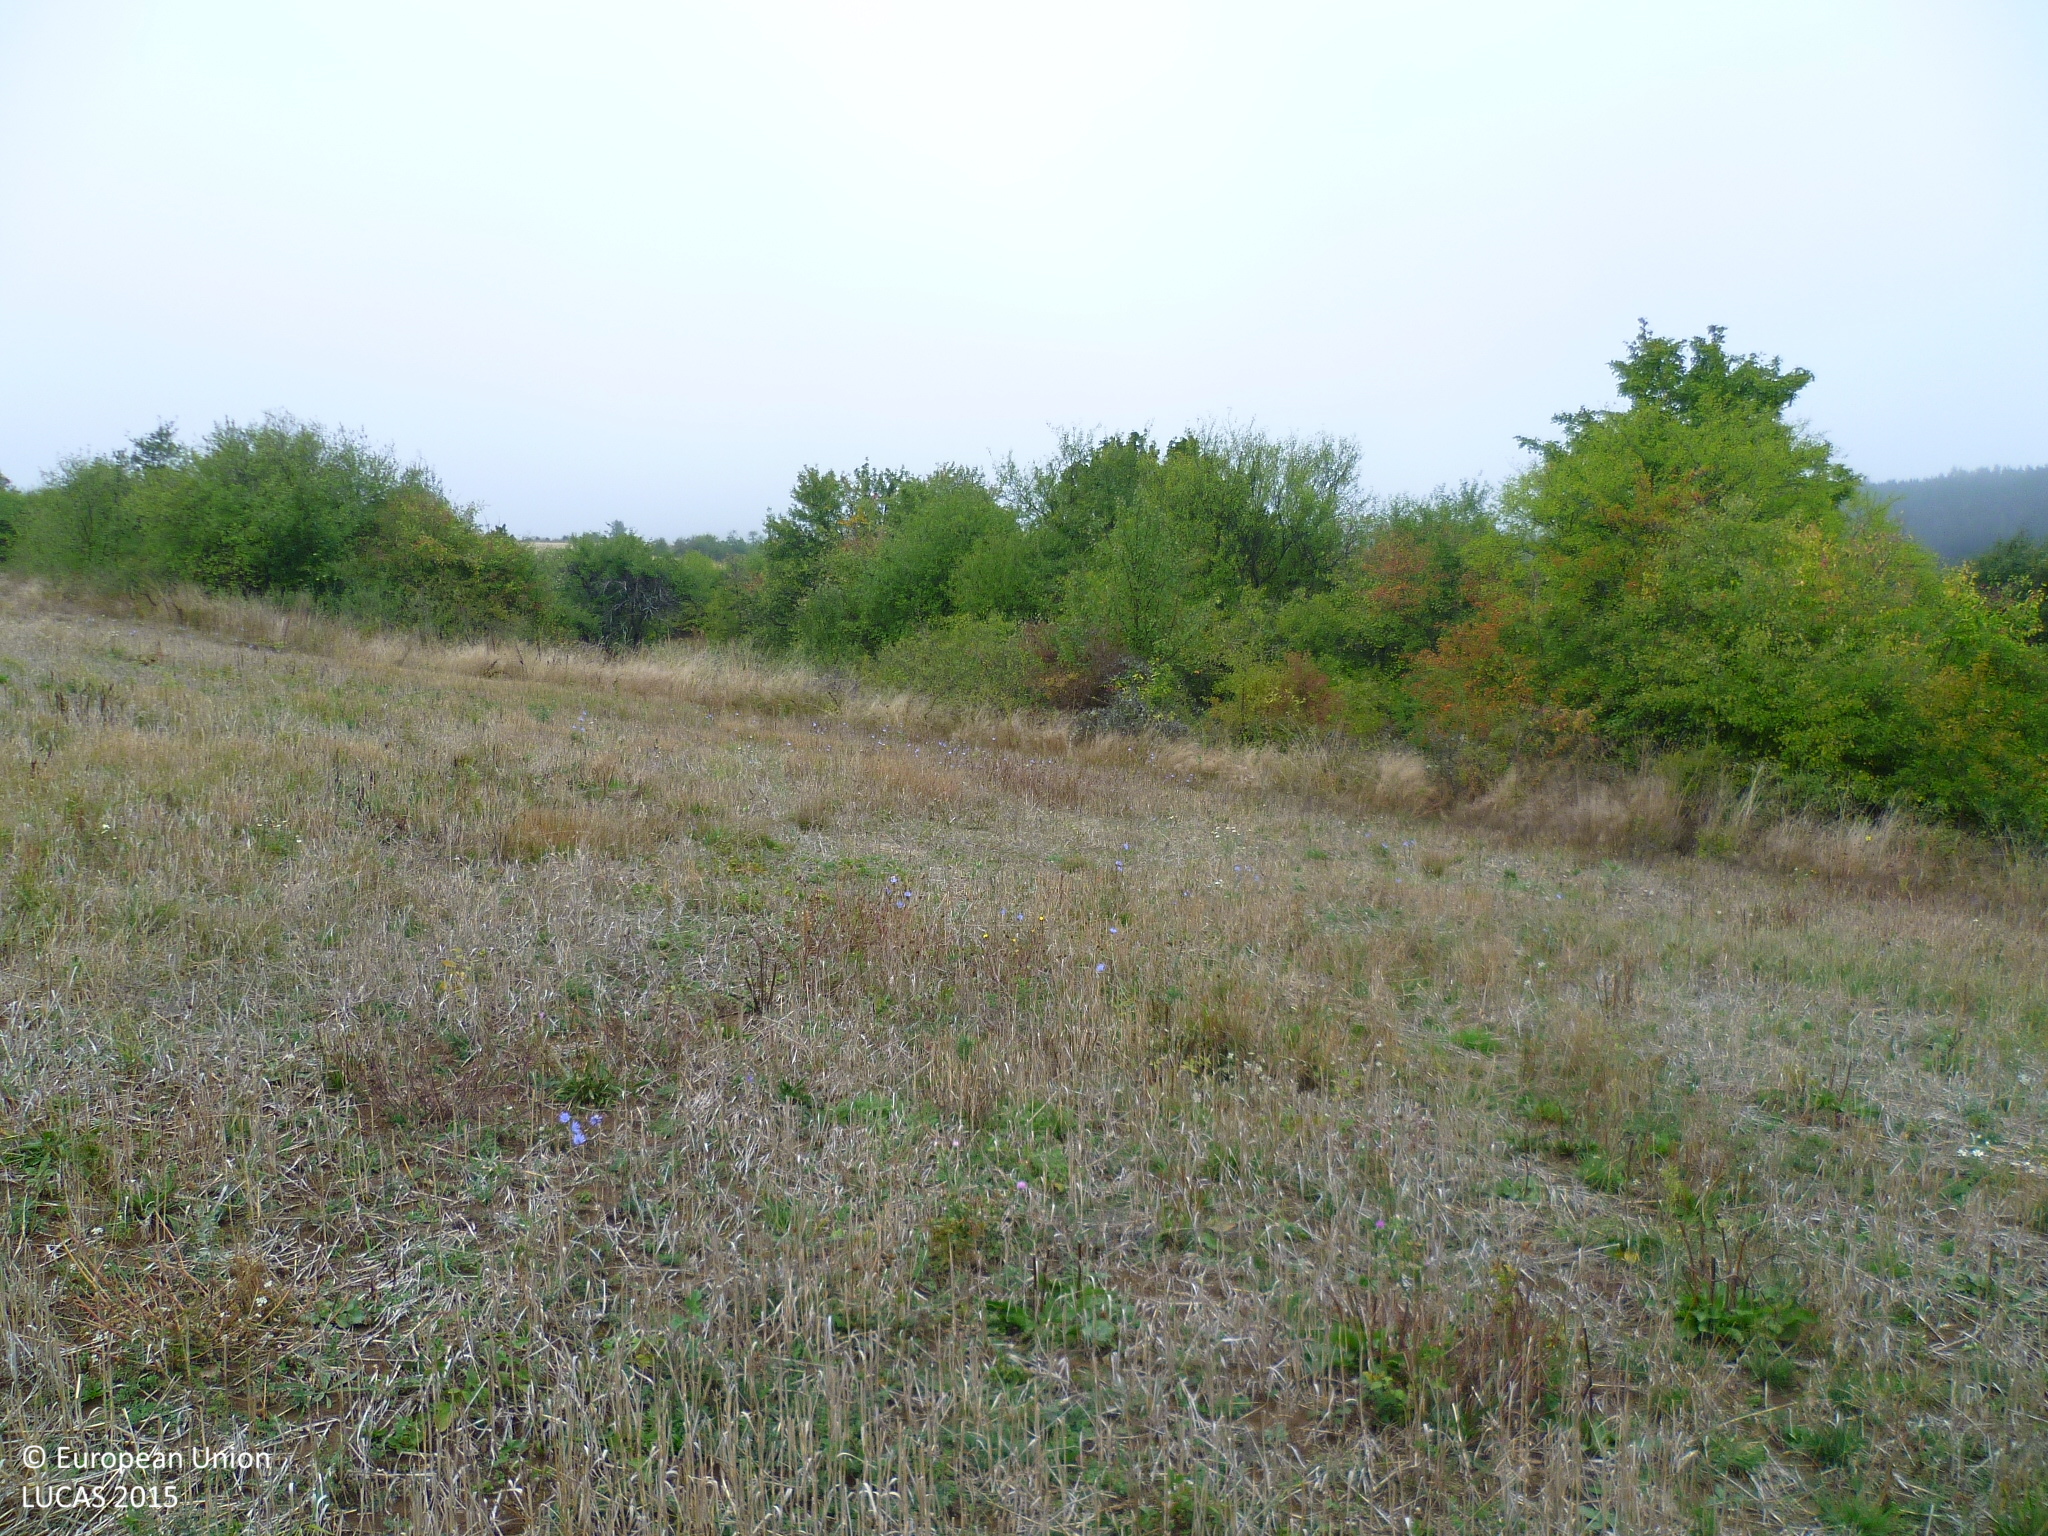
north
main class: Cropland
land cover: Barley
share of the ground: > 75 %
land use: Agriculture (excluding fallow land and kitchen gardens)
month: September
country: BG
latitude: 42.8013
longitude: 22.9793
